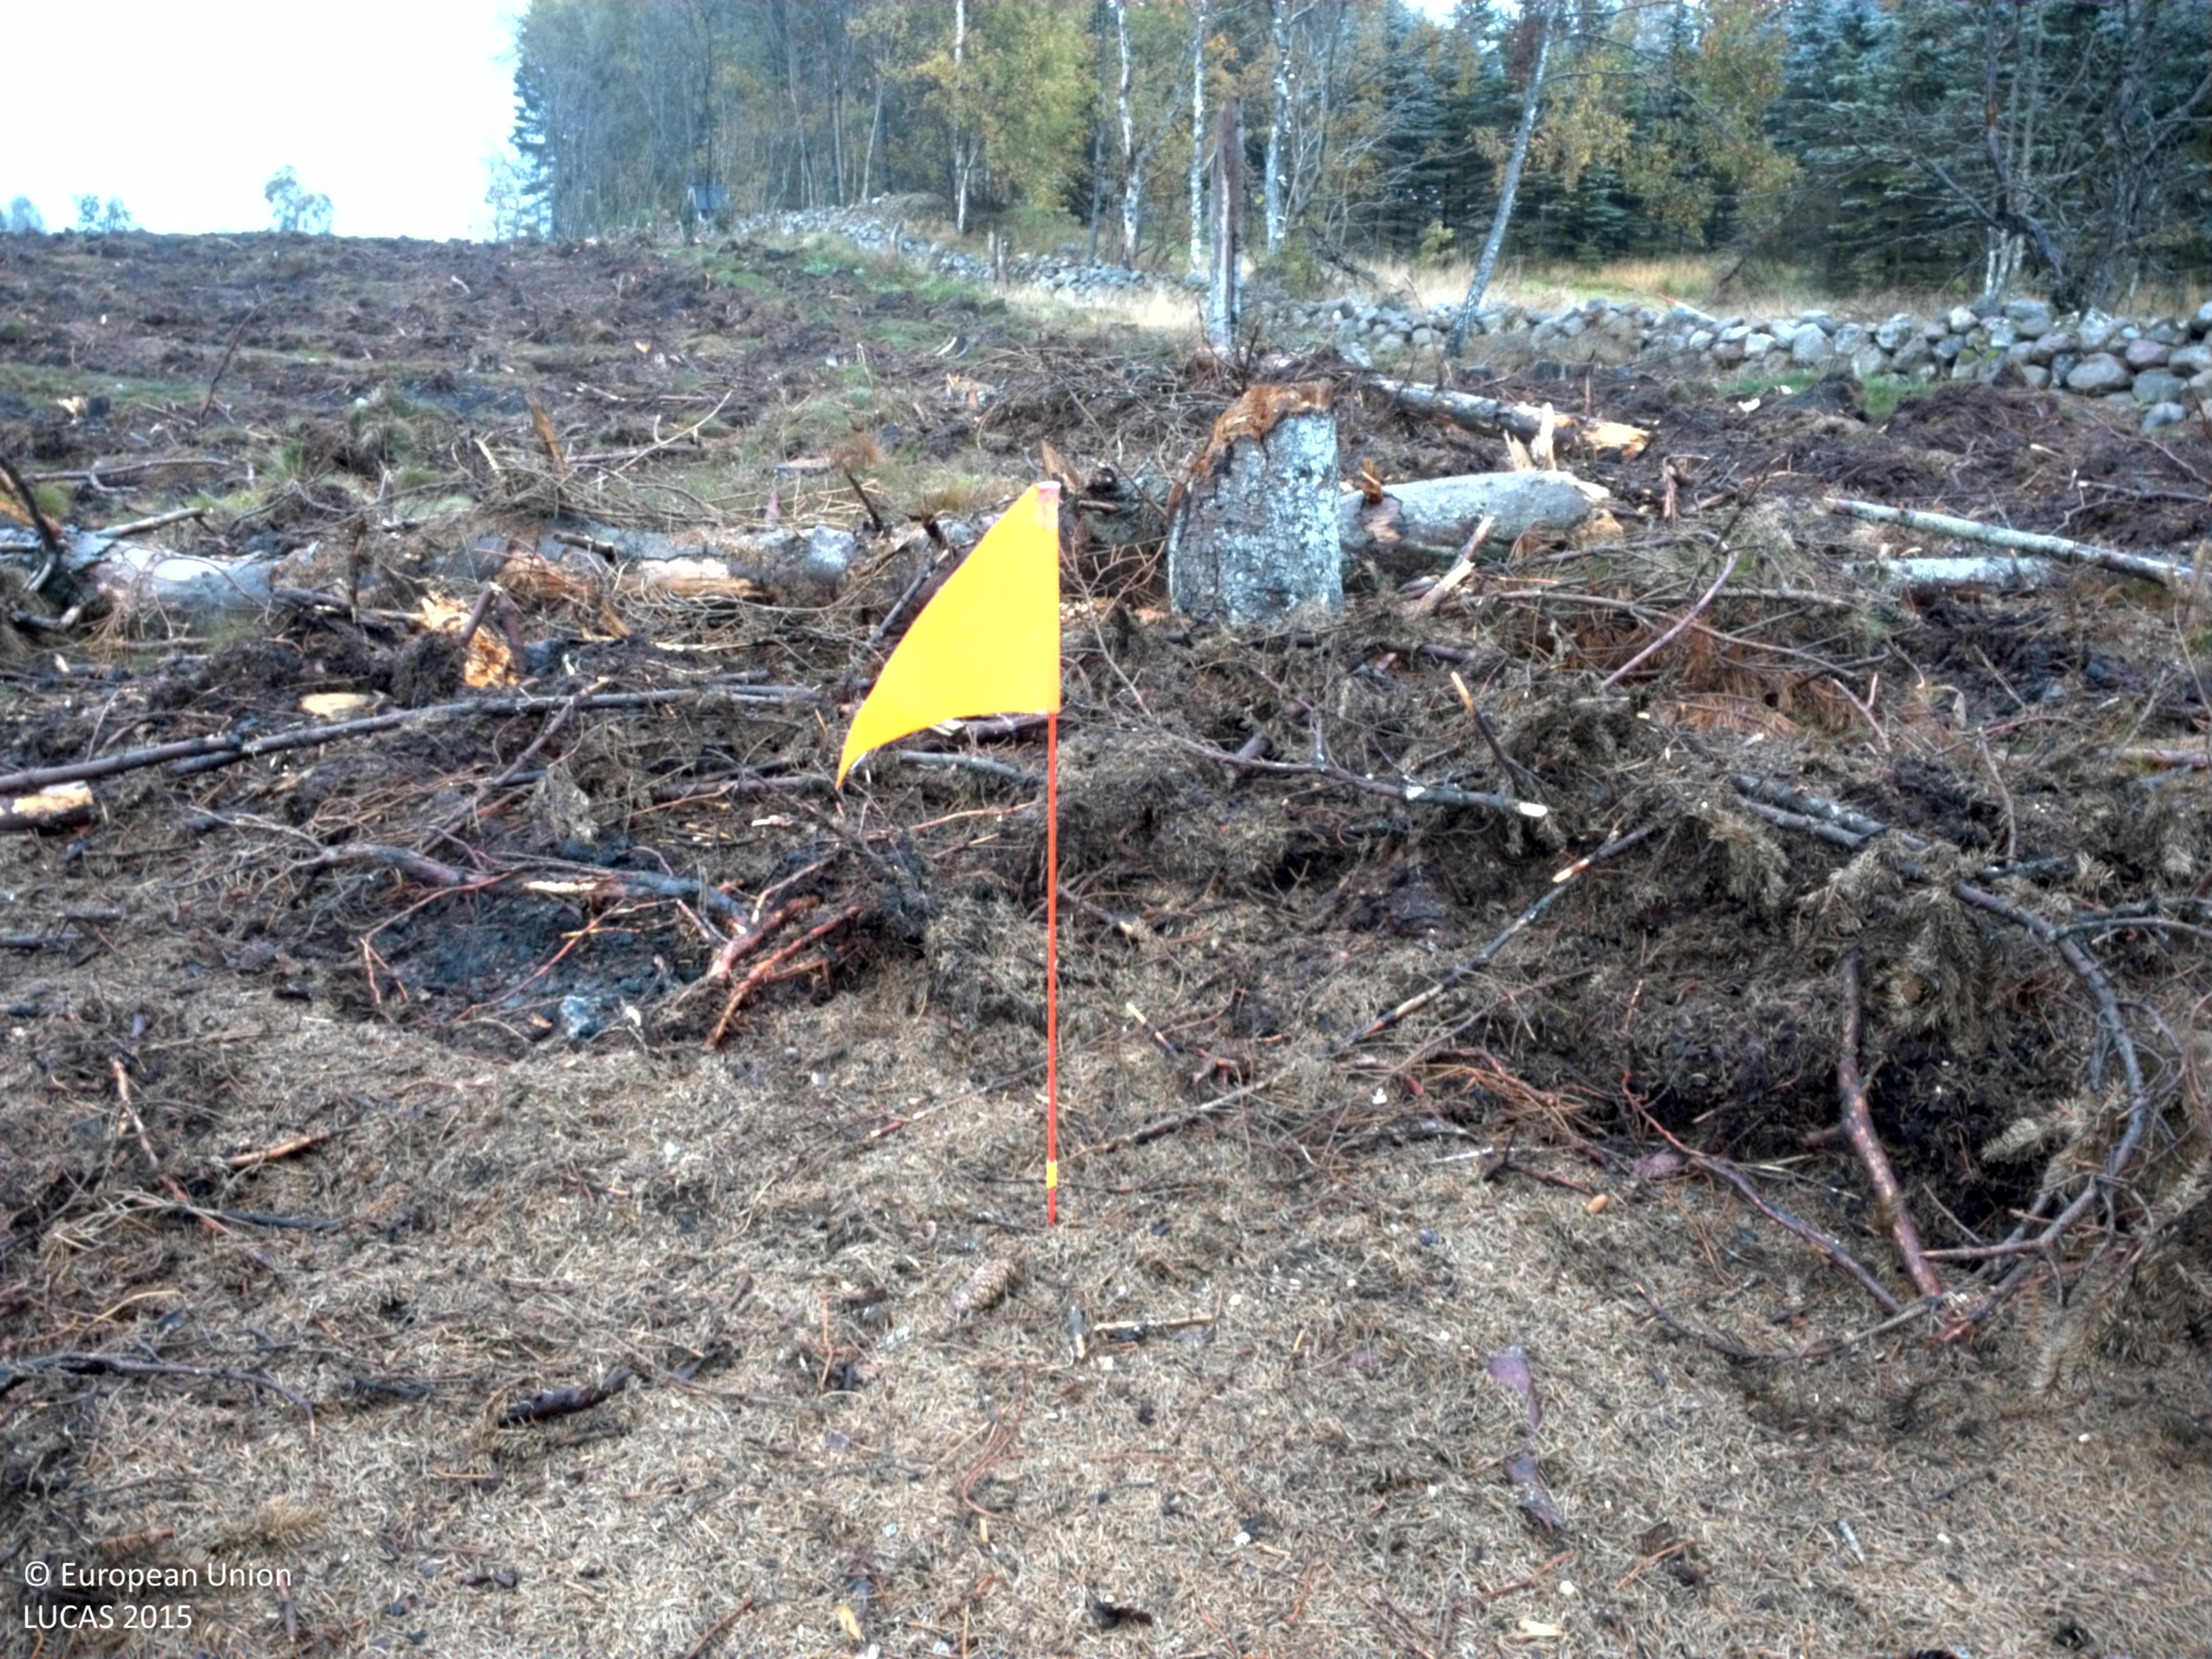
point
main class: Grassland
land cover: Grassland without tree/shrub cover
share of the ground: 10 - 25 %
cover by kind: unconsolidated bare surface 40 %, herbaceous plants 15 %
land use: Forestry
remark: Clear cut
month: October
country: SE
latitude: 55.7296
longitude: 13.9951
